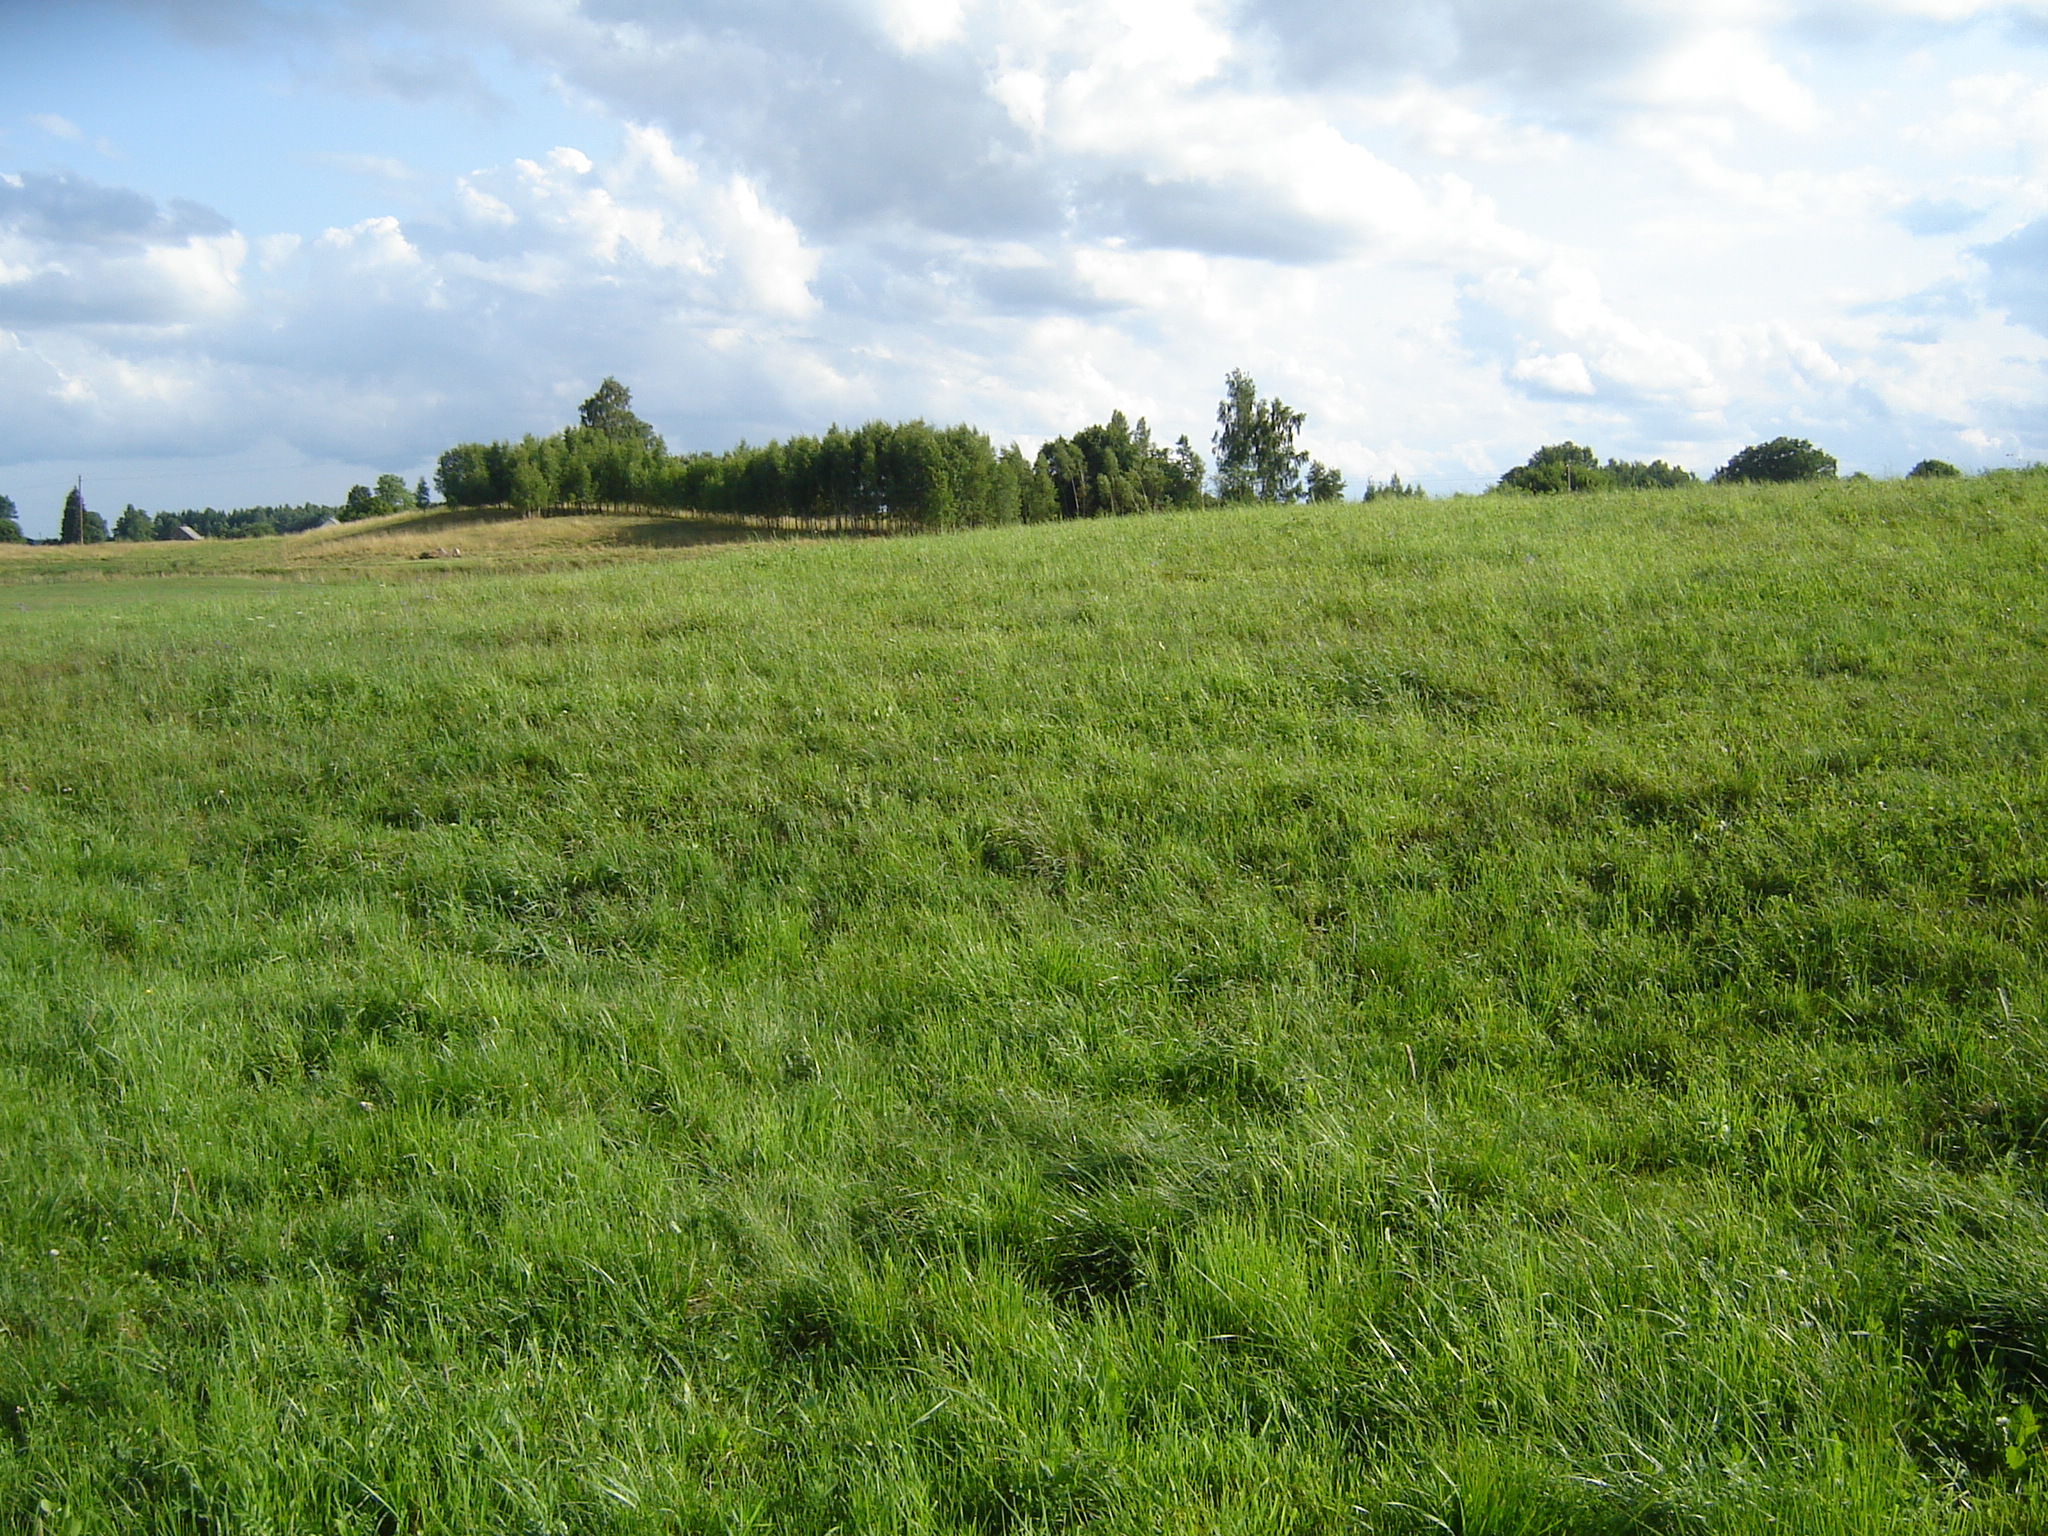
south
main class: Grassland
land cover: Grassland without tree/shrub cover
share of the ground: > 75 %
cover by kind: herbaceous plants 100 %
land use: Agriculture (excluding fallow land and kitchen gardens)
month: July
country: LT
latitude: 55.3125
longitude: 25.4866
